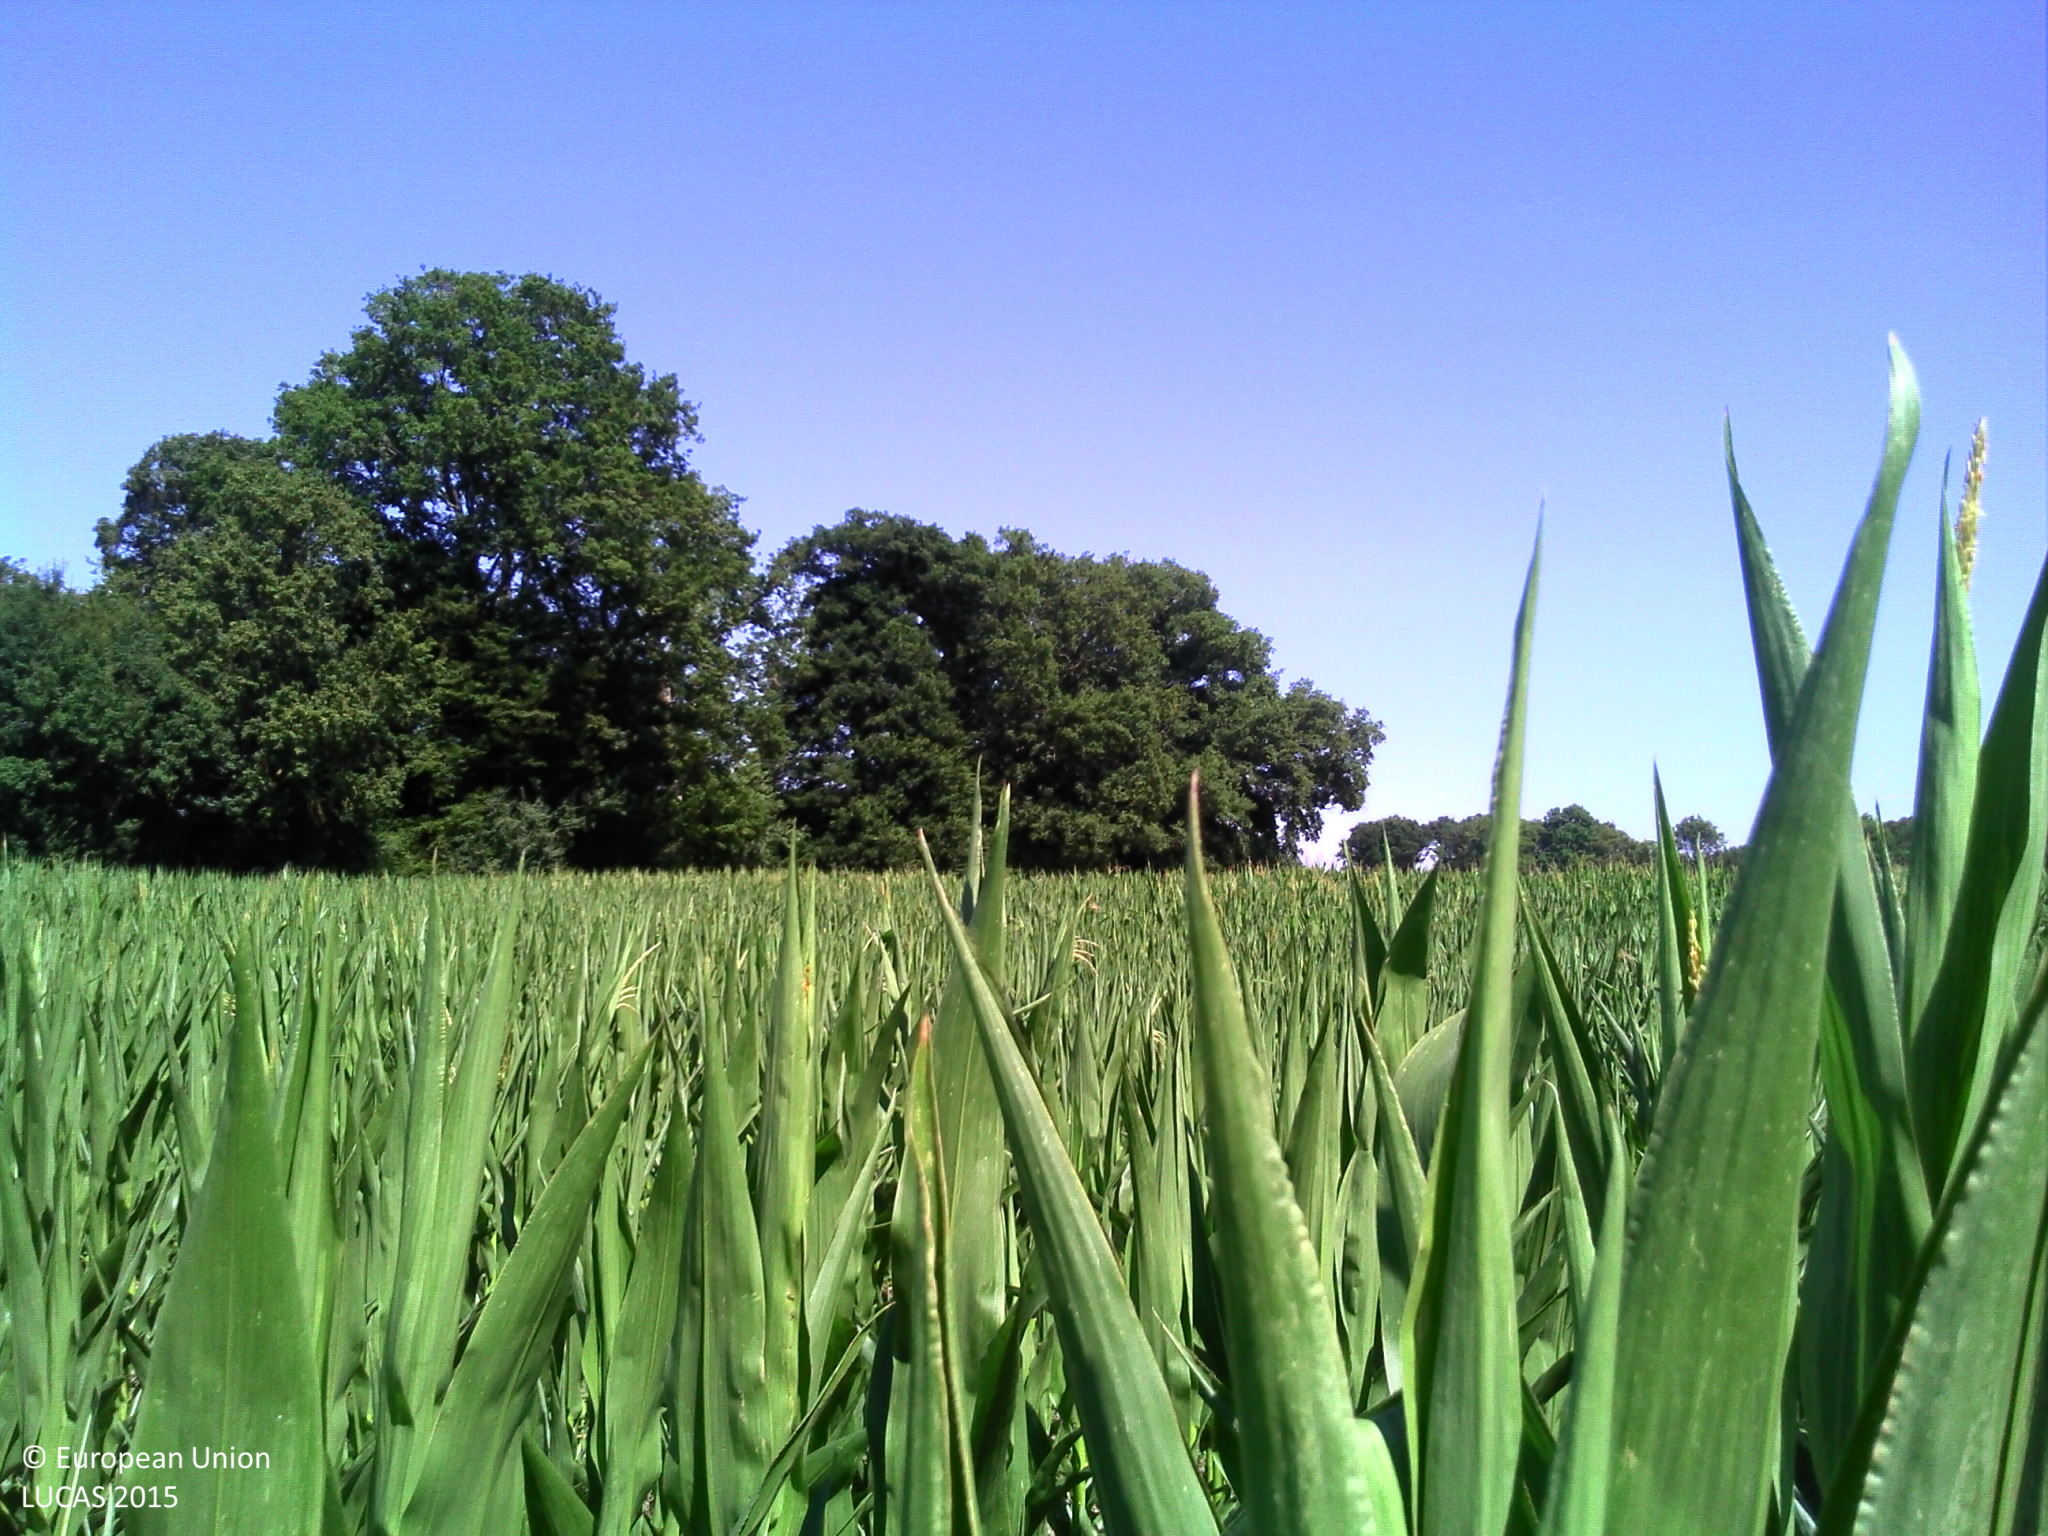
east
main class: Cropland
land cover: Maize
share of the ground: > 75 %
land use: Agriculture (excluding fallow land and kitchen gardens)
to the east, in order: Maize; Grass margins; Broadleaved woodland; Fences; Grassland without tree/shrub cover; Broadleaved woodland; Grass margins; Inland fresh water bodies; Lines of trees; Grassland without tree/shrub cover; Sunflower
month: July
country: FR
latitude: 47.9663
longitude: 2.4765
